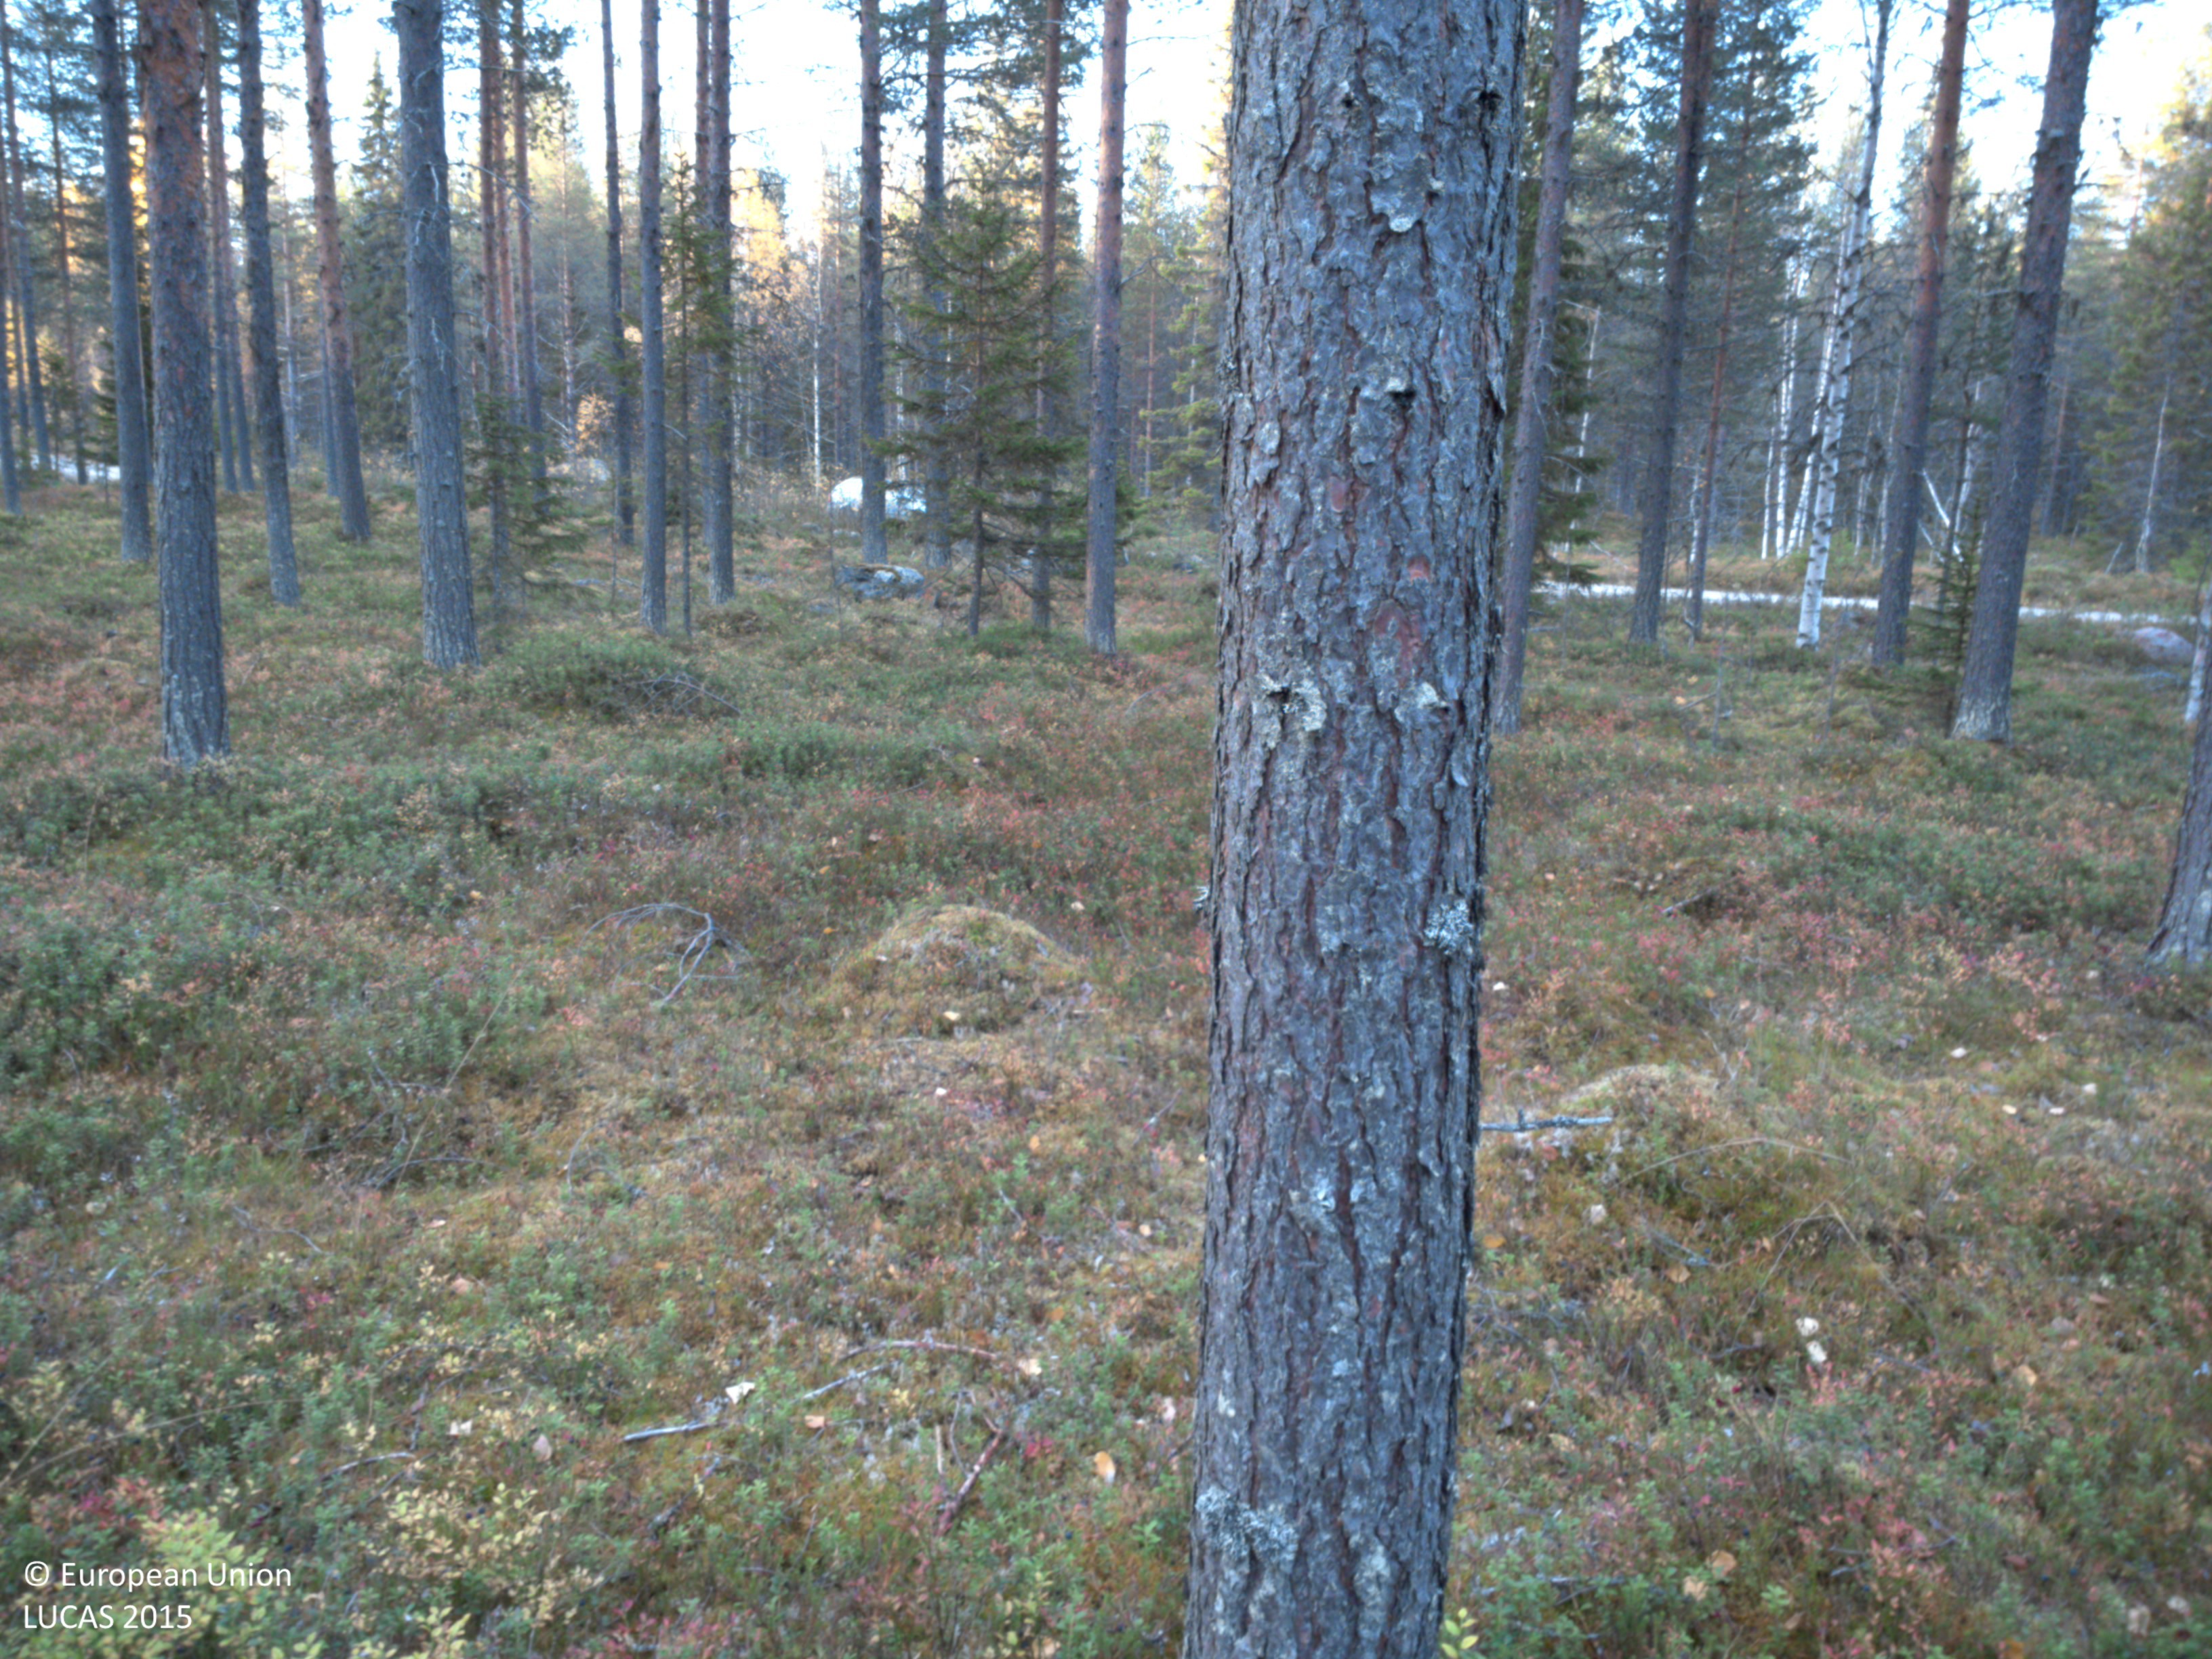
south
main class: Woodland
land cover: Pine dominated coniferous woodland
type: boreal forest
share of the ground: 50 - 75 %
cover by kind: coniferous forest trees 75 %, shrubs 15 %, lichens and mosses 10 %
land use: Forestry
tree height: > 5 m
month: October
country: SE
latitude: 64.9631
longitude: 18.2870
